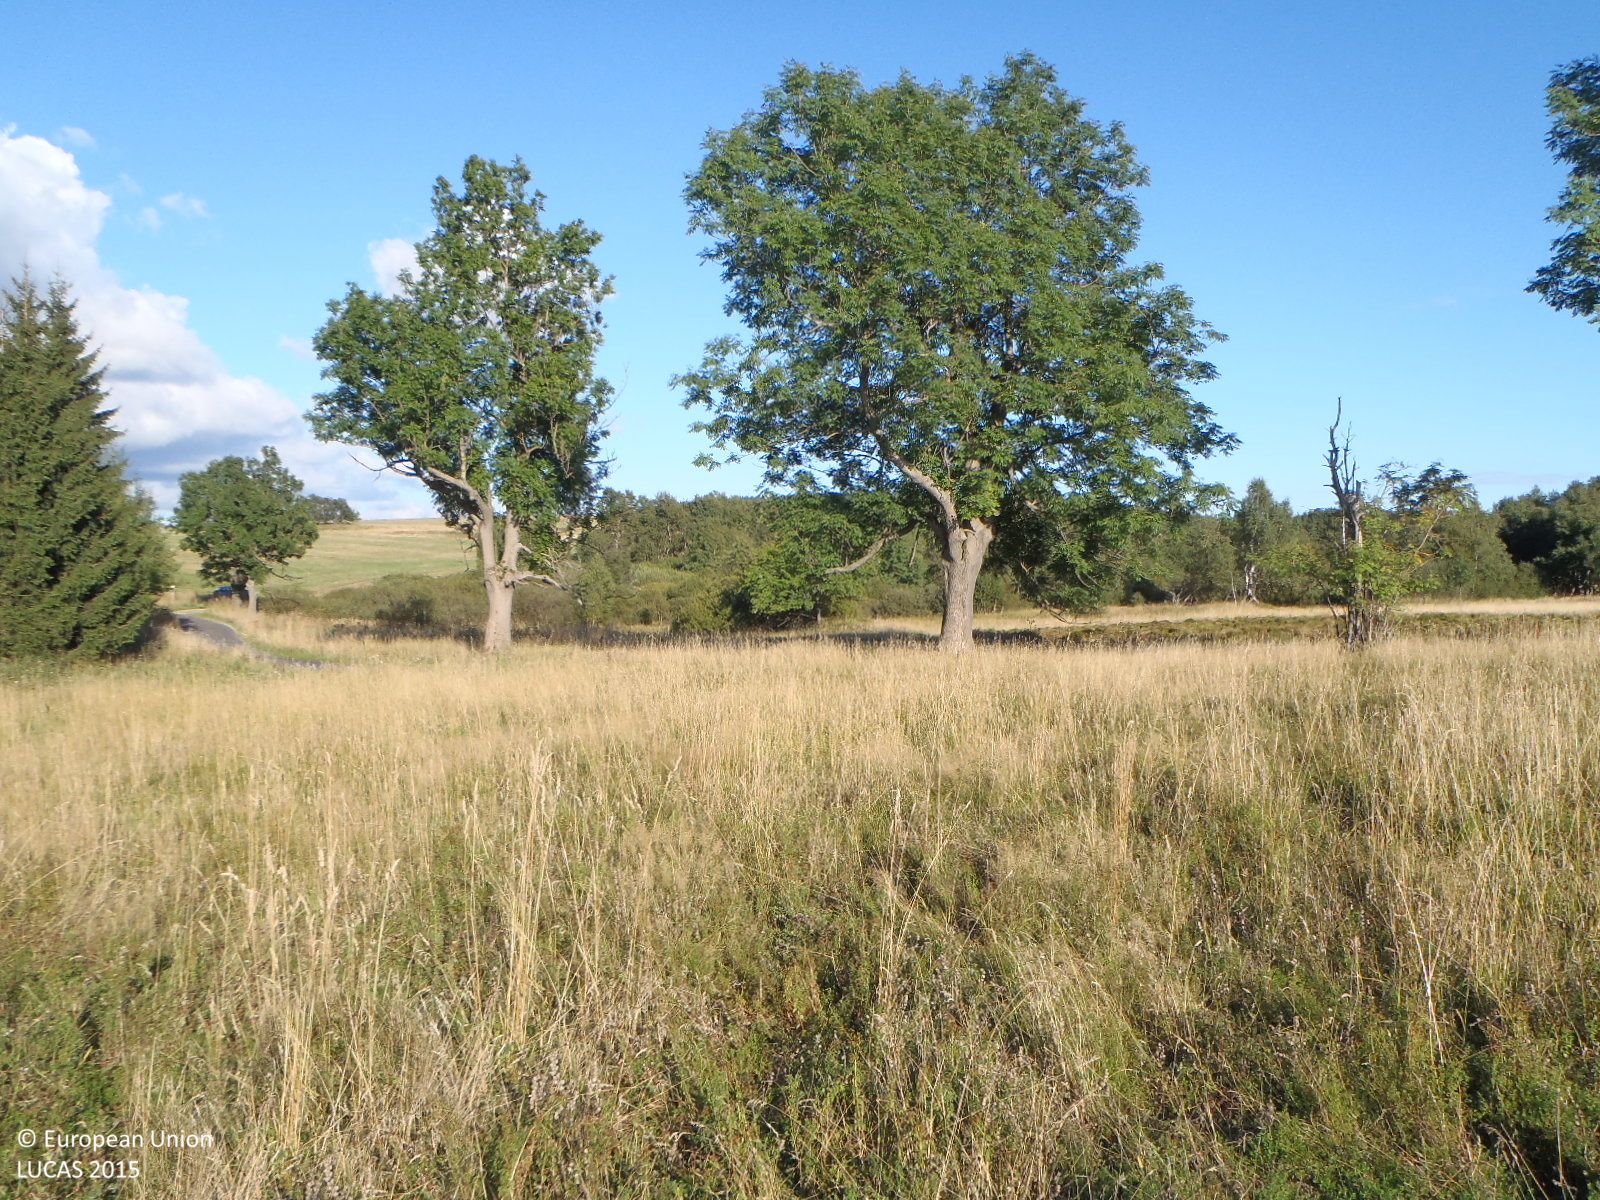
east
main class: Grassland
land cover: Grassland without tree/shrub cover
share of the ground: > 75 %
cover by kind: herbaceous plants 100 %
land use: Agriculture (excluding fallow land and kitchen gardens)
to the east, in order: Grassland without tree/shrub cover; Paved roads, cycling and walking lanes; Lines of trees; Grassland without tree/shrub cover; Inland marshes; Broadleaved woodland; Grassland without tree/shrub cover; Broadleaved woodland; Rivers and streams; Broadleaved woodland; Shrubland with sparse tree cover; Broadleaved woodland; Grassland with sparse tree/shrub cover
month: September
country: CZ
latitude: 50.7297
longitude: 13.8969
